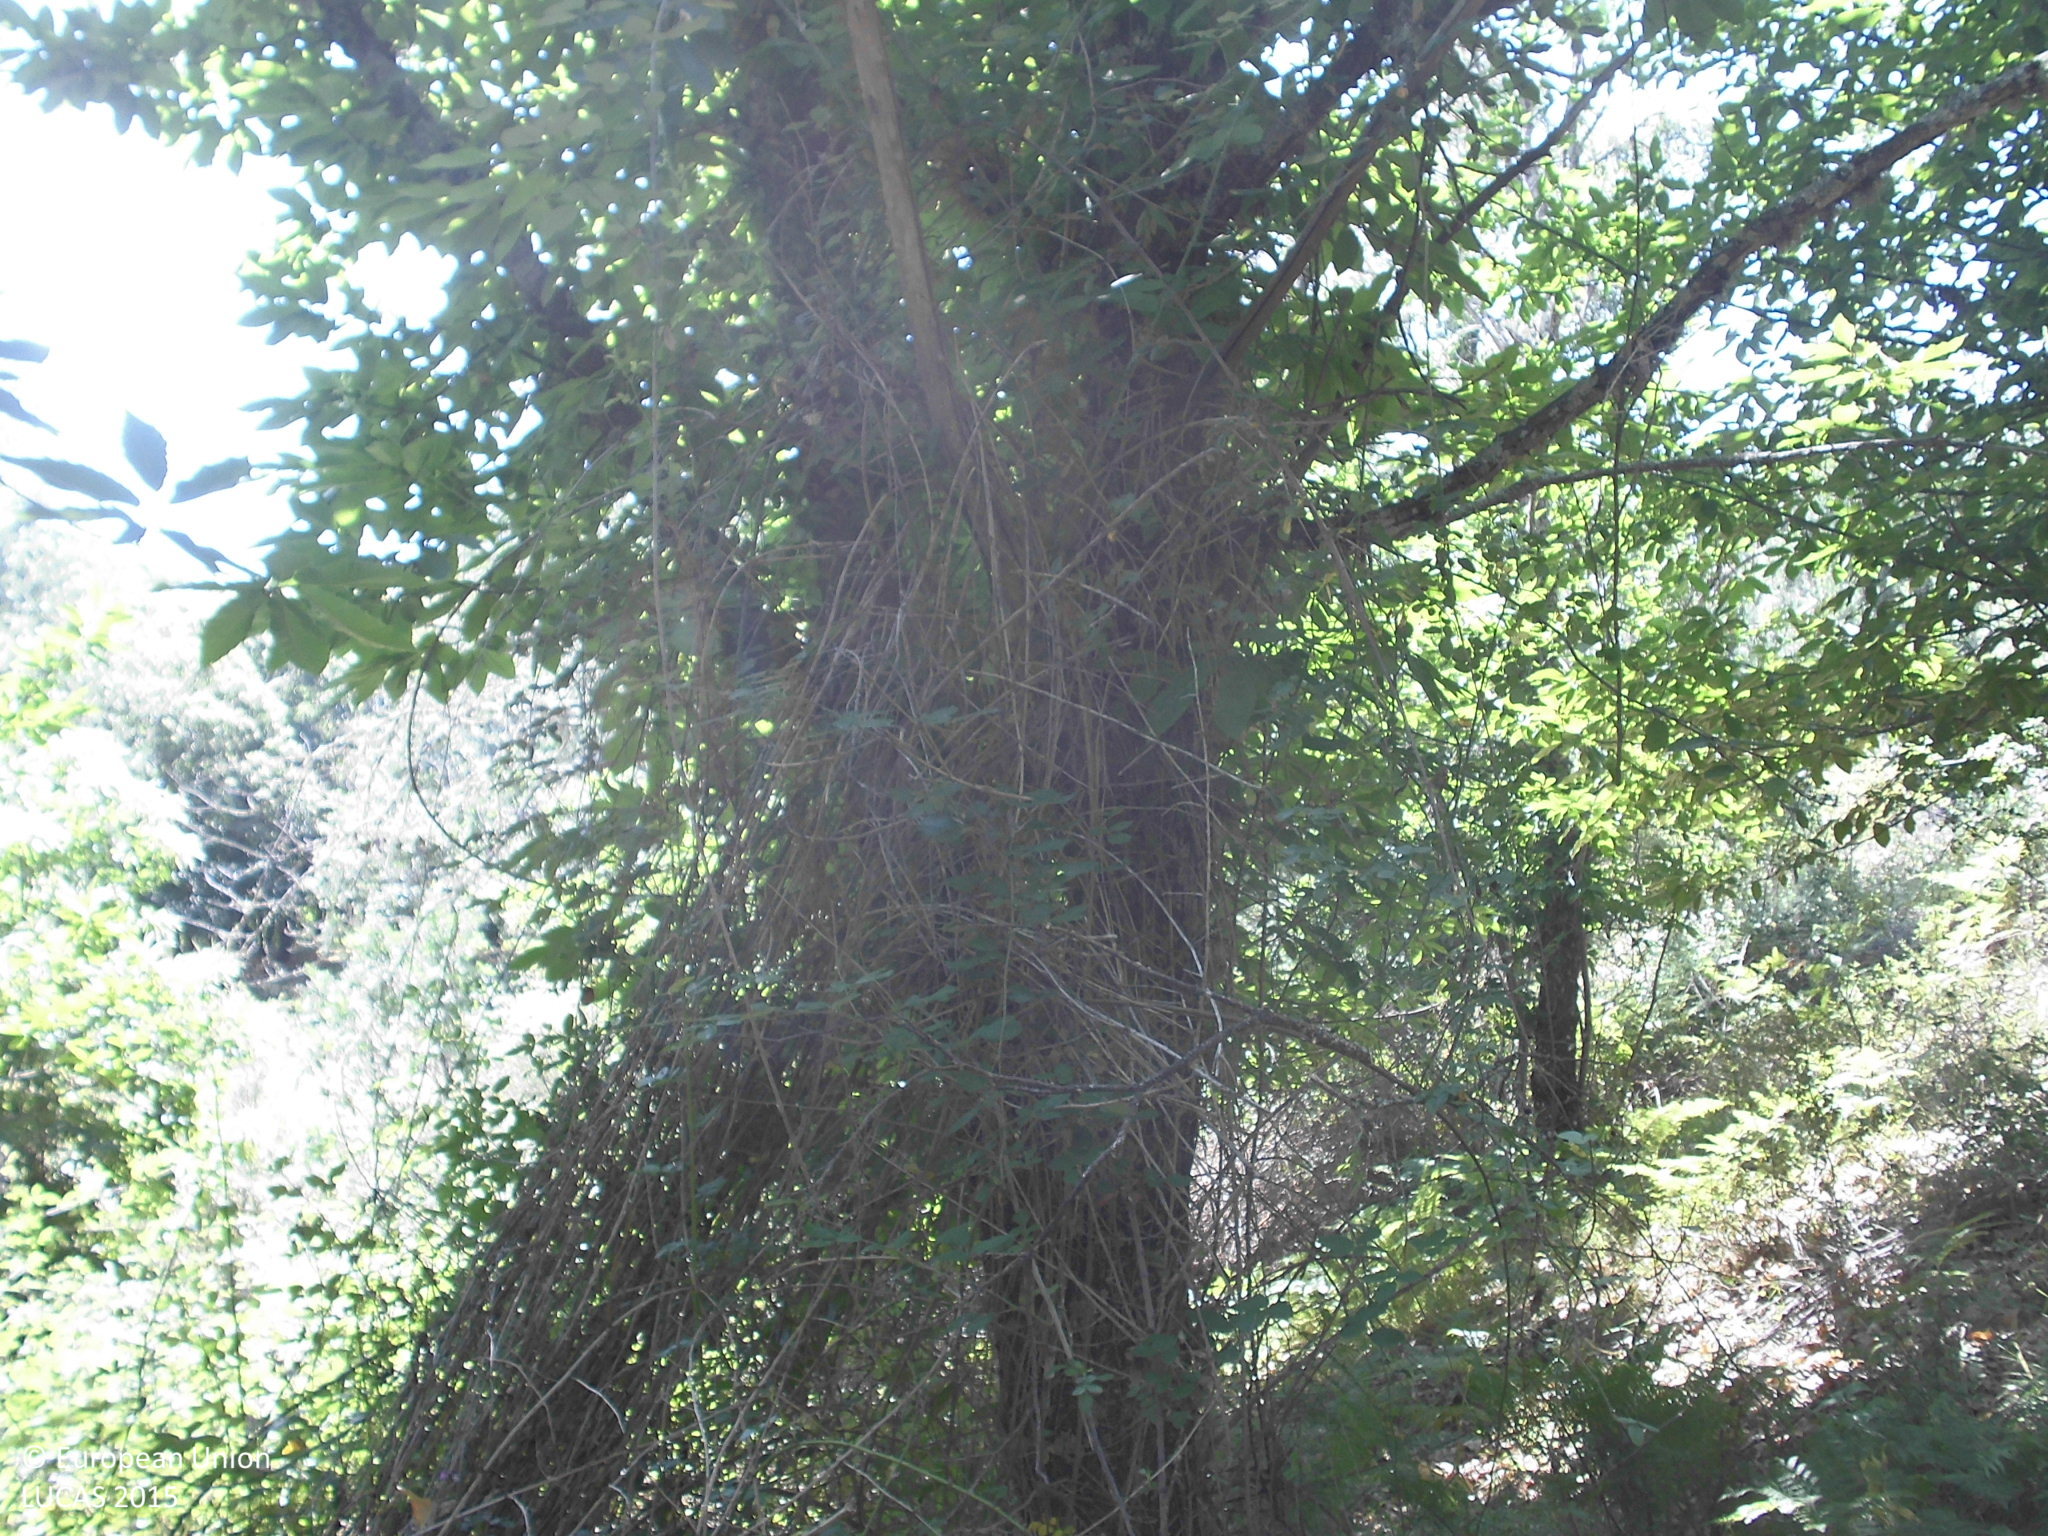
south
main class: Woodland
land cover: Broadleaved woodland
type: thermophilous deciduous forest
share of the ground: > 75 %
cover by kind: broadleaved forest trees 75 %, herbaceous plants 15 %, shrubs 10 %
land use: Forestry
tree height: > 5 m
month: June
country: ES
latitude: 39.5258
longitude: -5.3711
